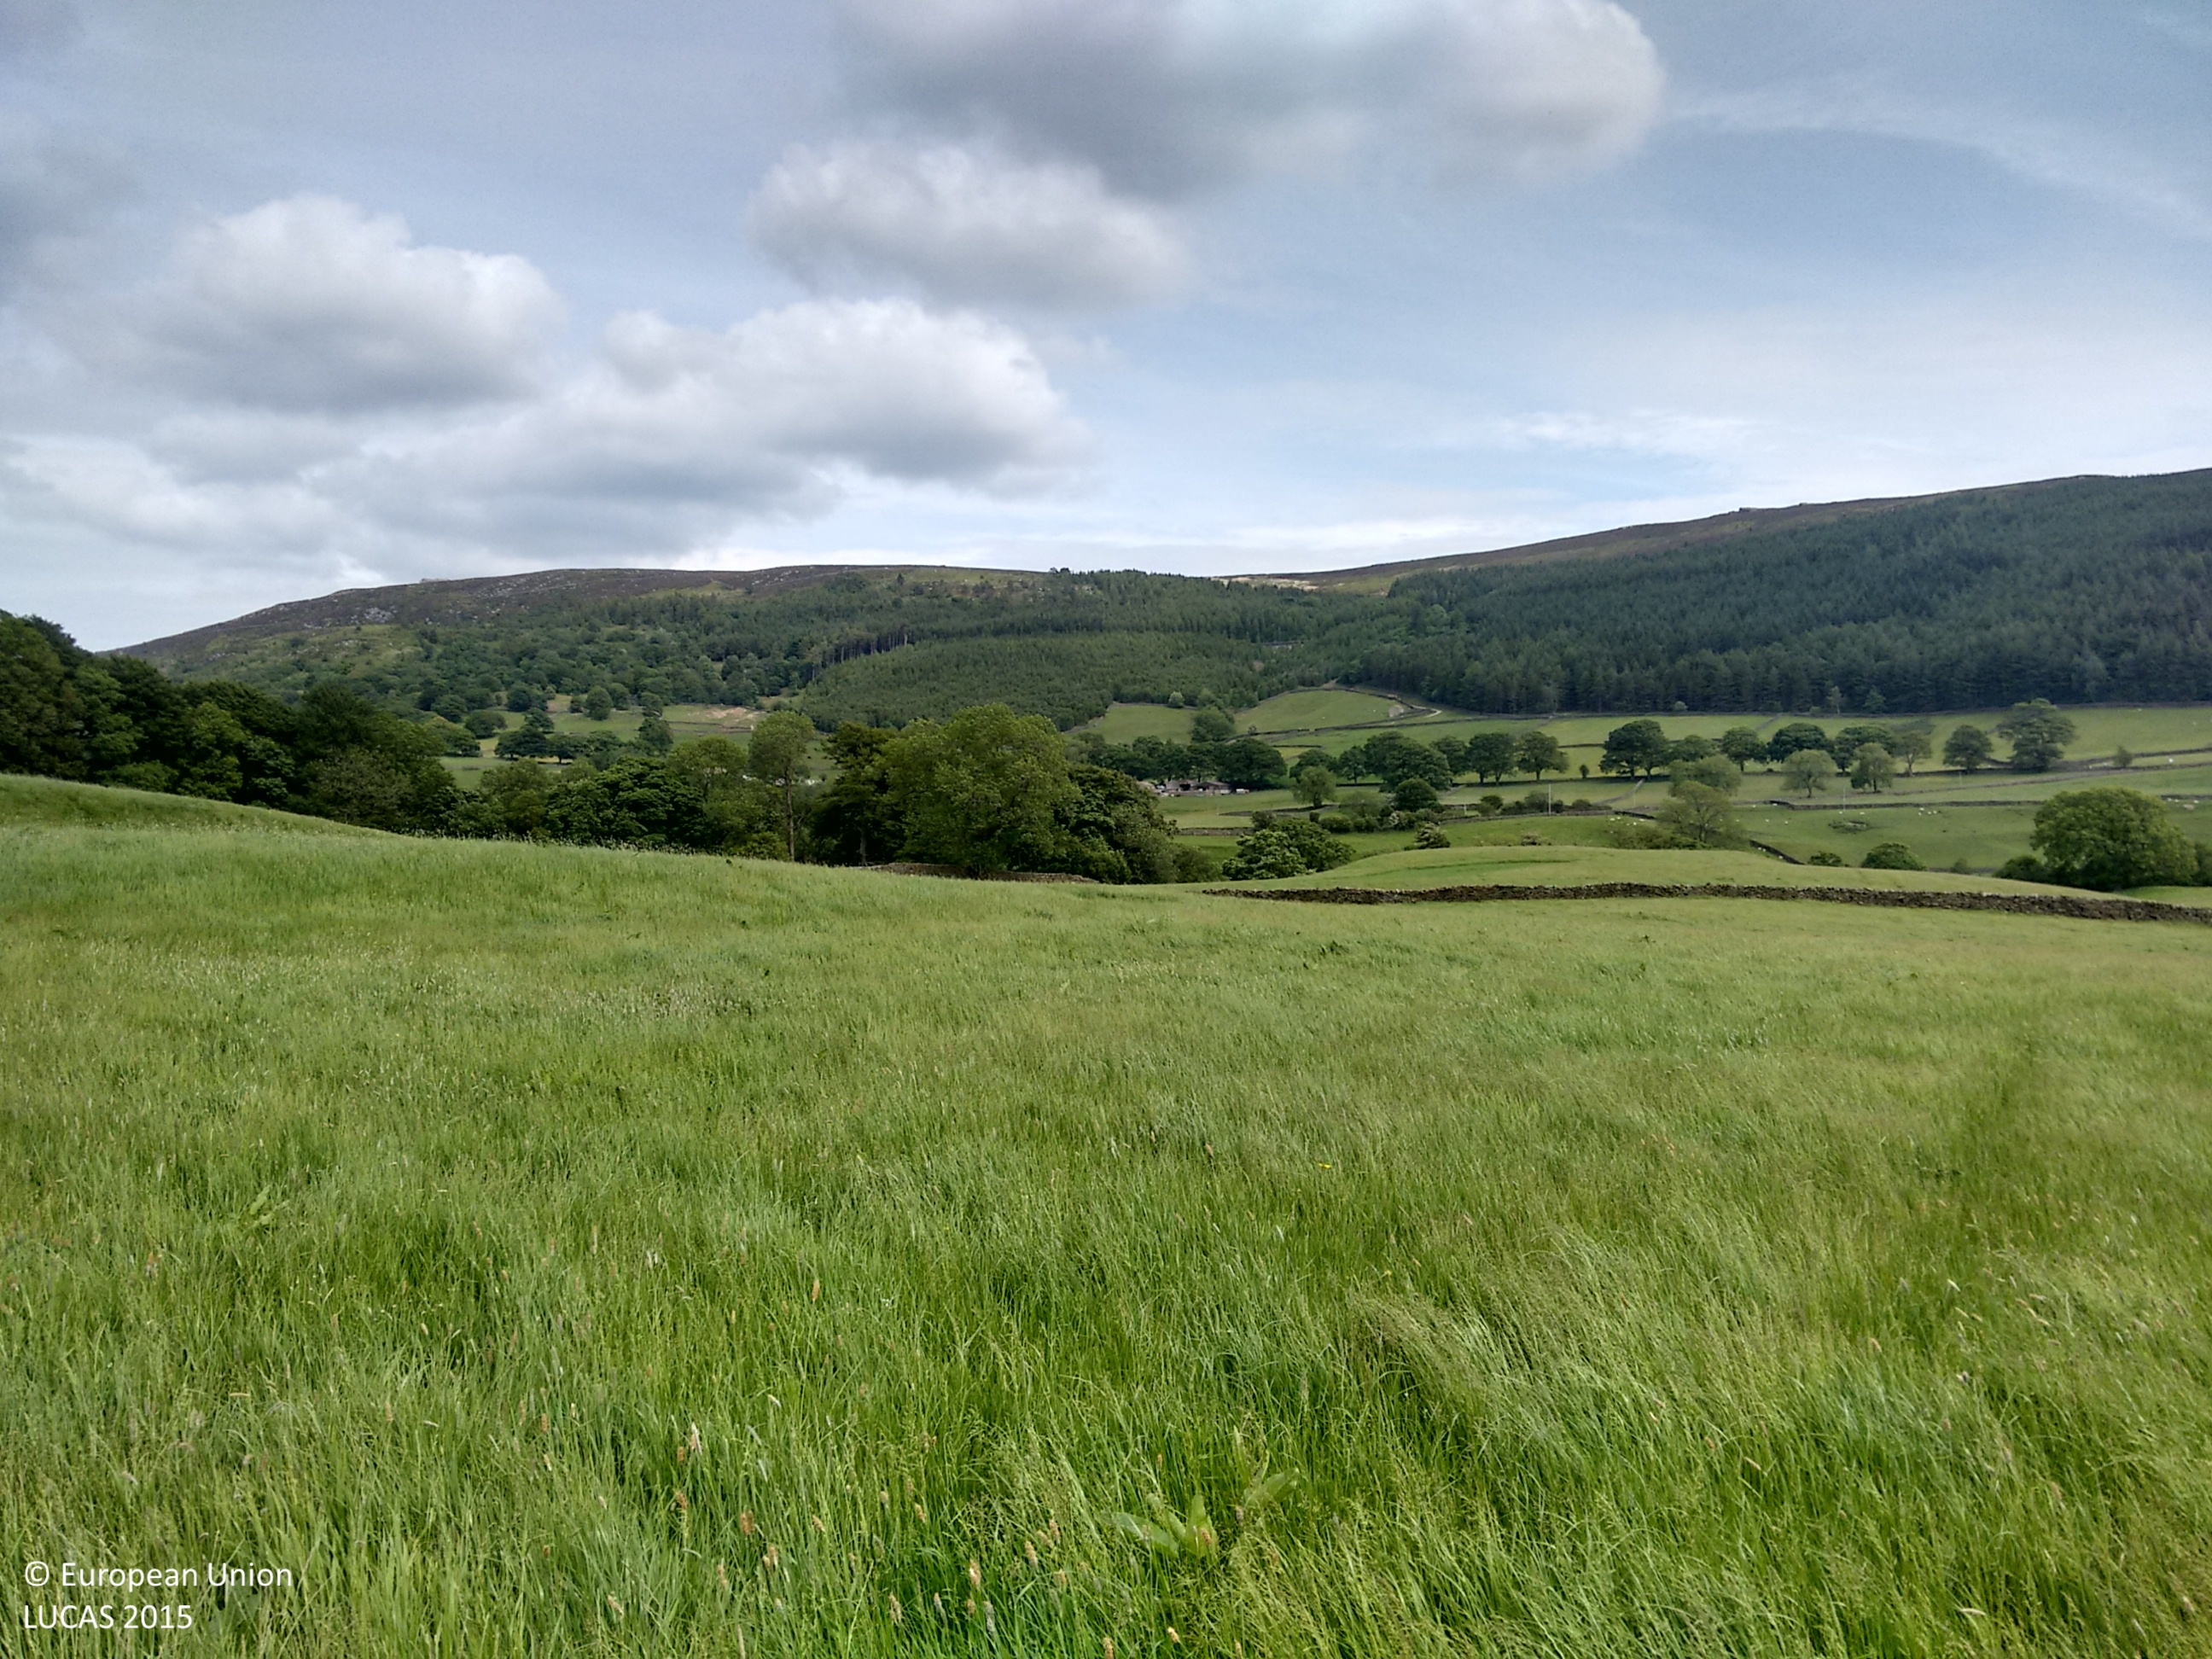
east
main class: Grassland
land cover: Grassland without tree/shrub cover
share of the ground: > 75 %
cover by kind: herbaceous plants 100 %
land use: Agriculture (excluding fallow land and kitchen gardens)
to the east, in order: Grassland without tree/shrub cover; Dry stone walls; Grassland without tree/shrub cover; Dry stone walls; Grassland without tree/shrub cover; Broadleaved woodland
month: June
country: GB
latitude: 54.0292
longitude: -1.9174
